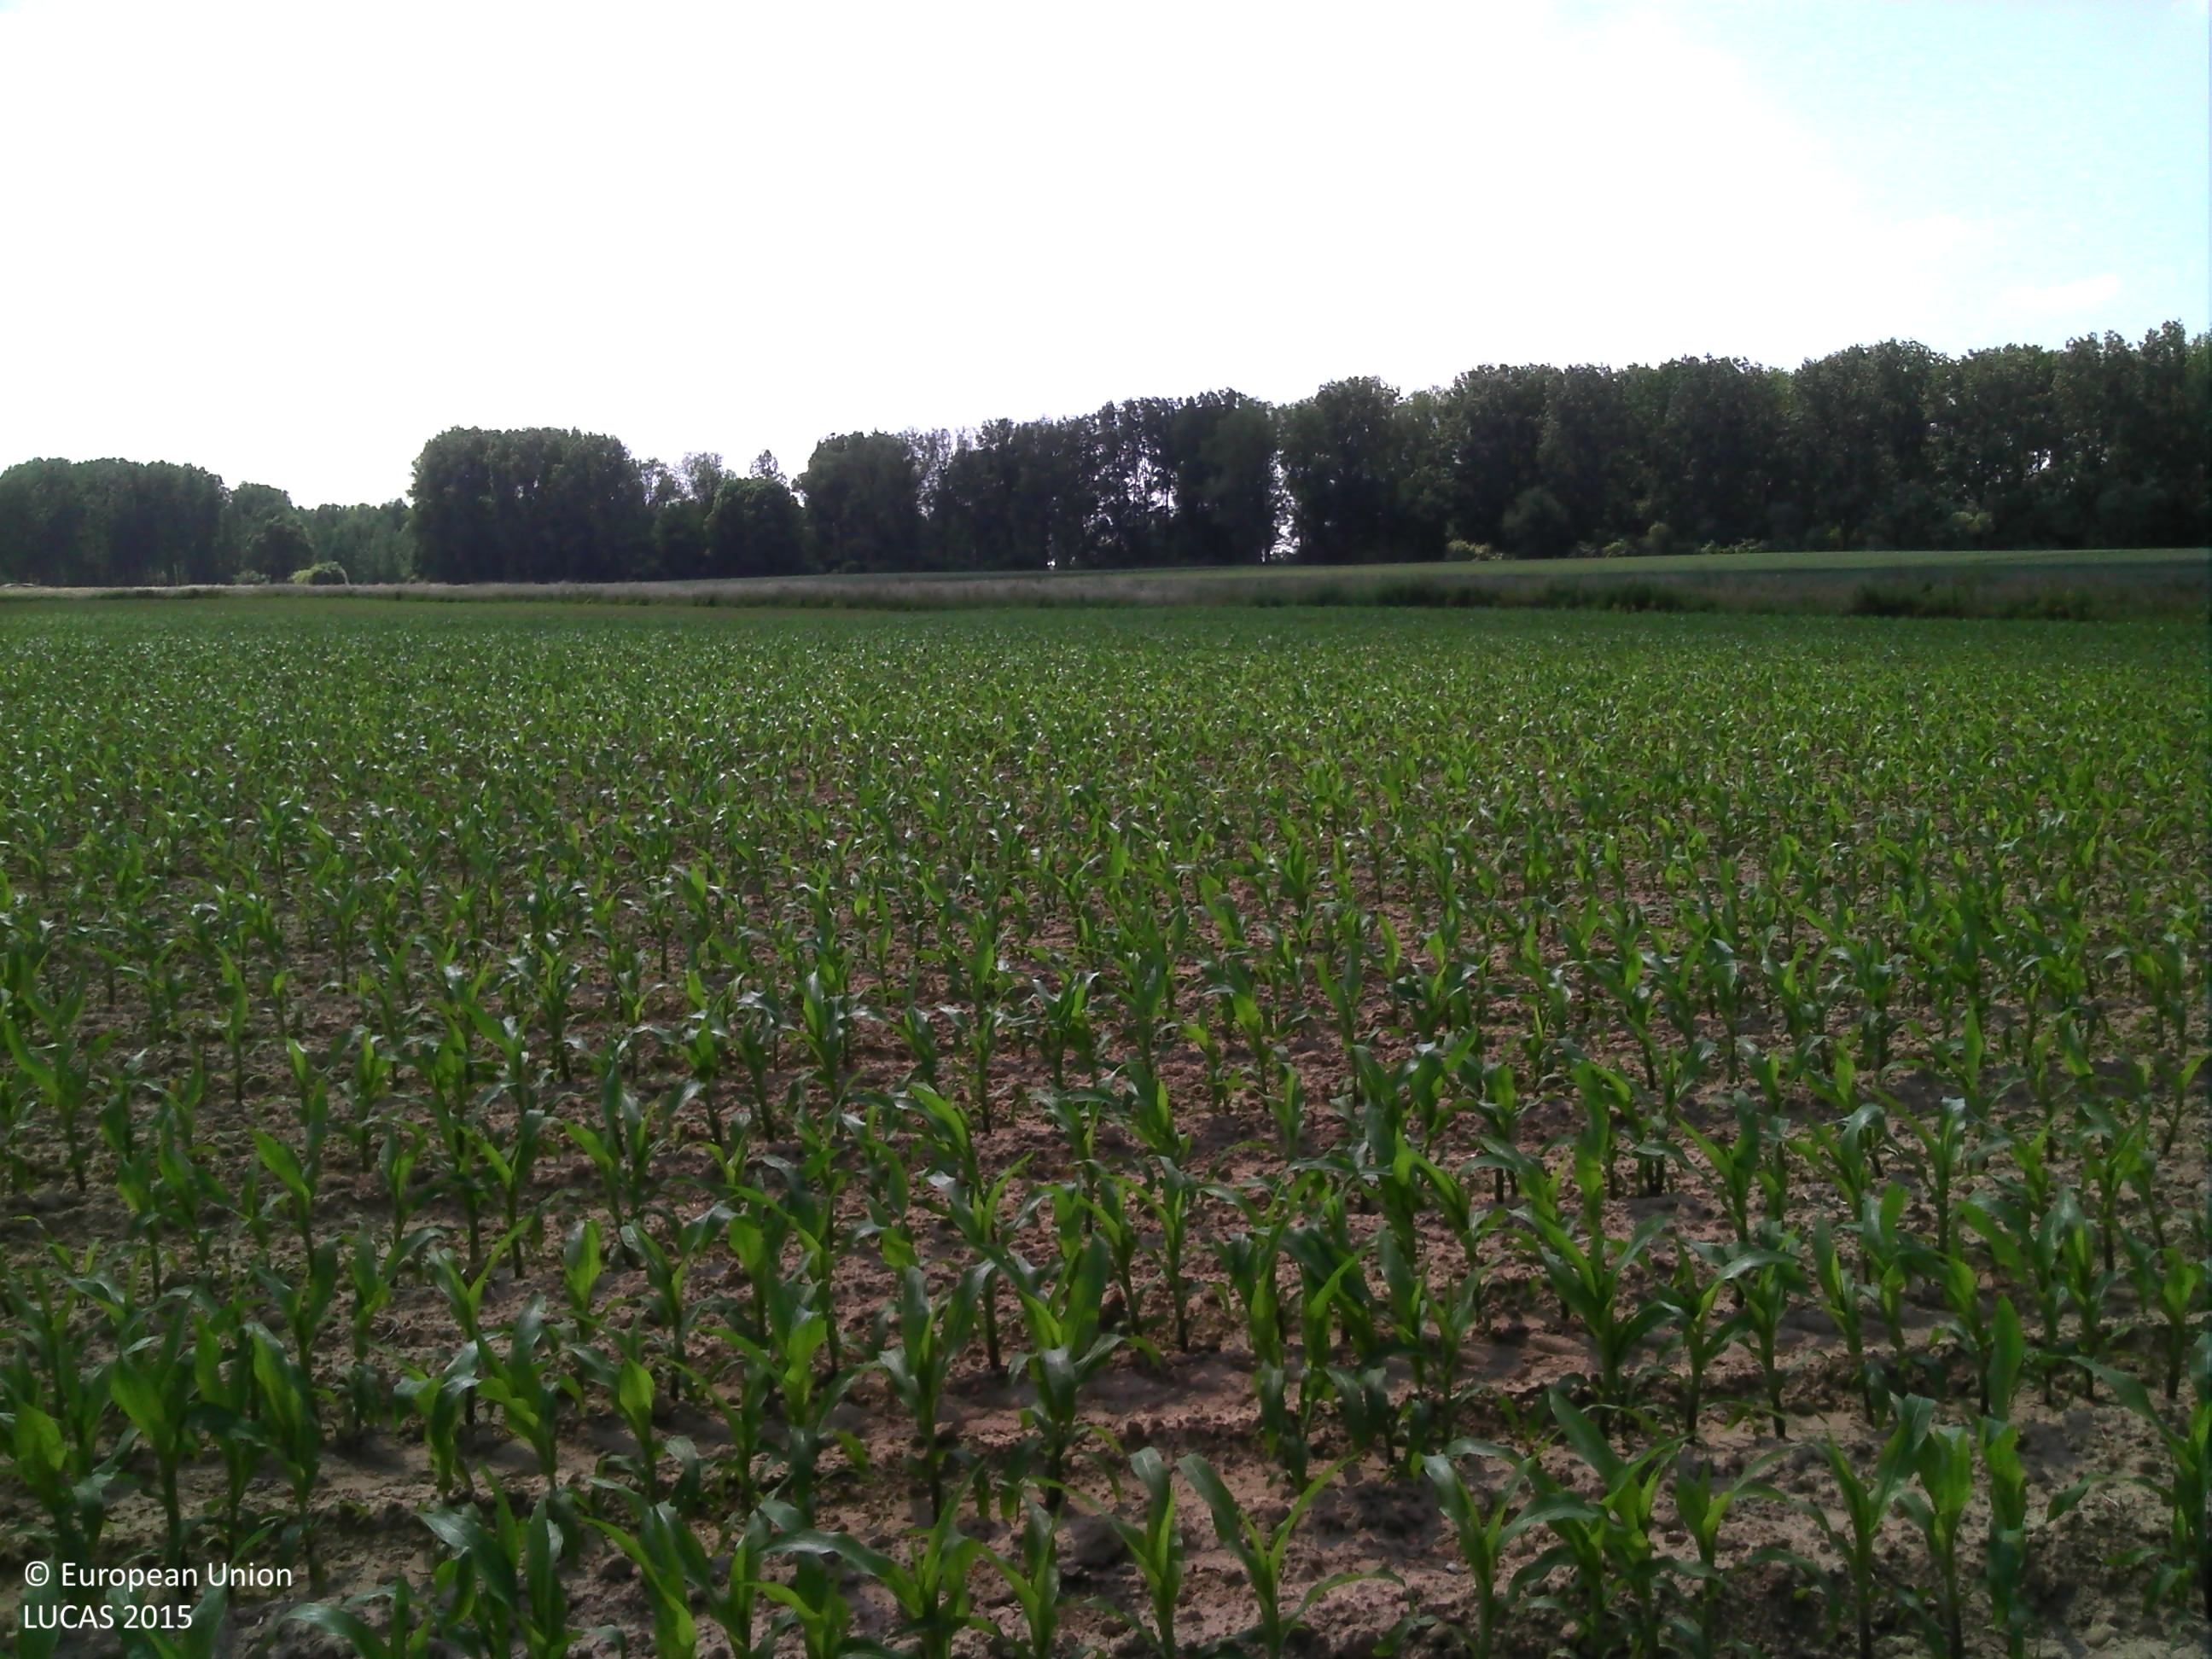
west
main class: Cropland
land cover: Maize
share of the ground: 25 - 50 %
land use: Agriculture (excluding fallow land and kitchen gardens)
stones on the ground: < 10 %
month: June
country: BE
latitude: 50.7597
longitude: 5.4474
